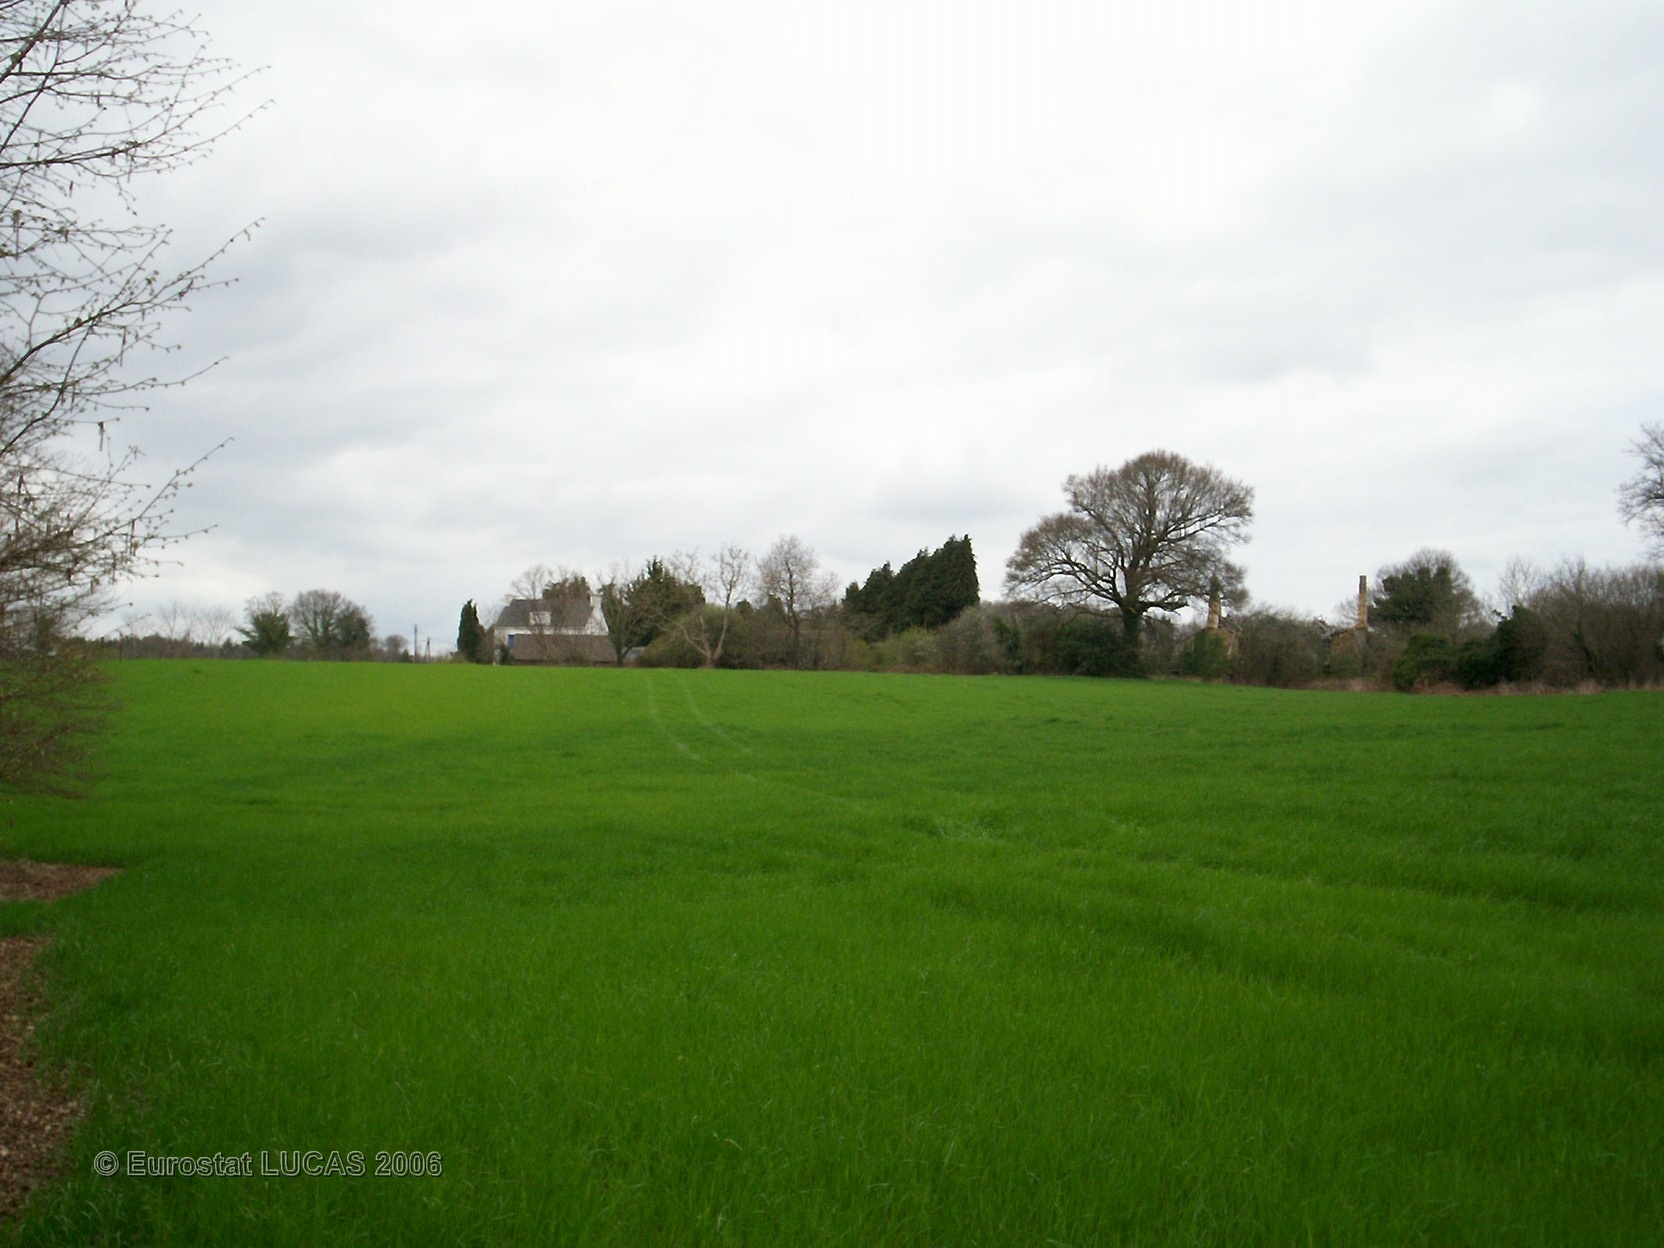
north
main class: Grassland
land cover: Grassland without tree/shrub cover
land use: Agriculture (excluding fallow land and kitchen gardens)
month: April
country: FR
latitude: 47.9321
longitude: -3.5288
